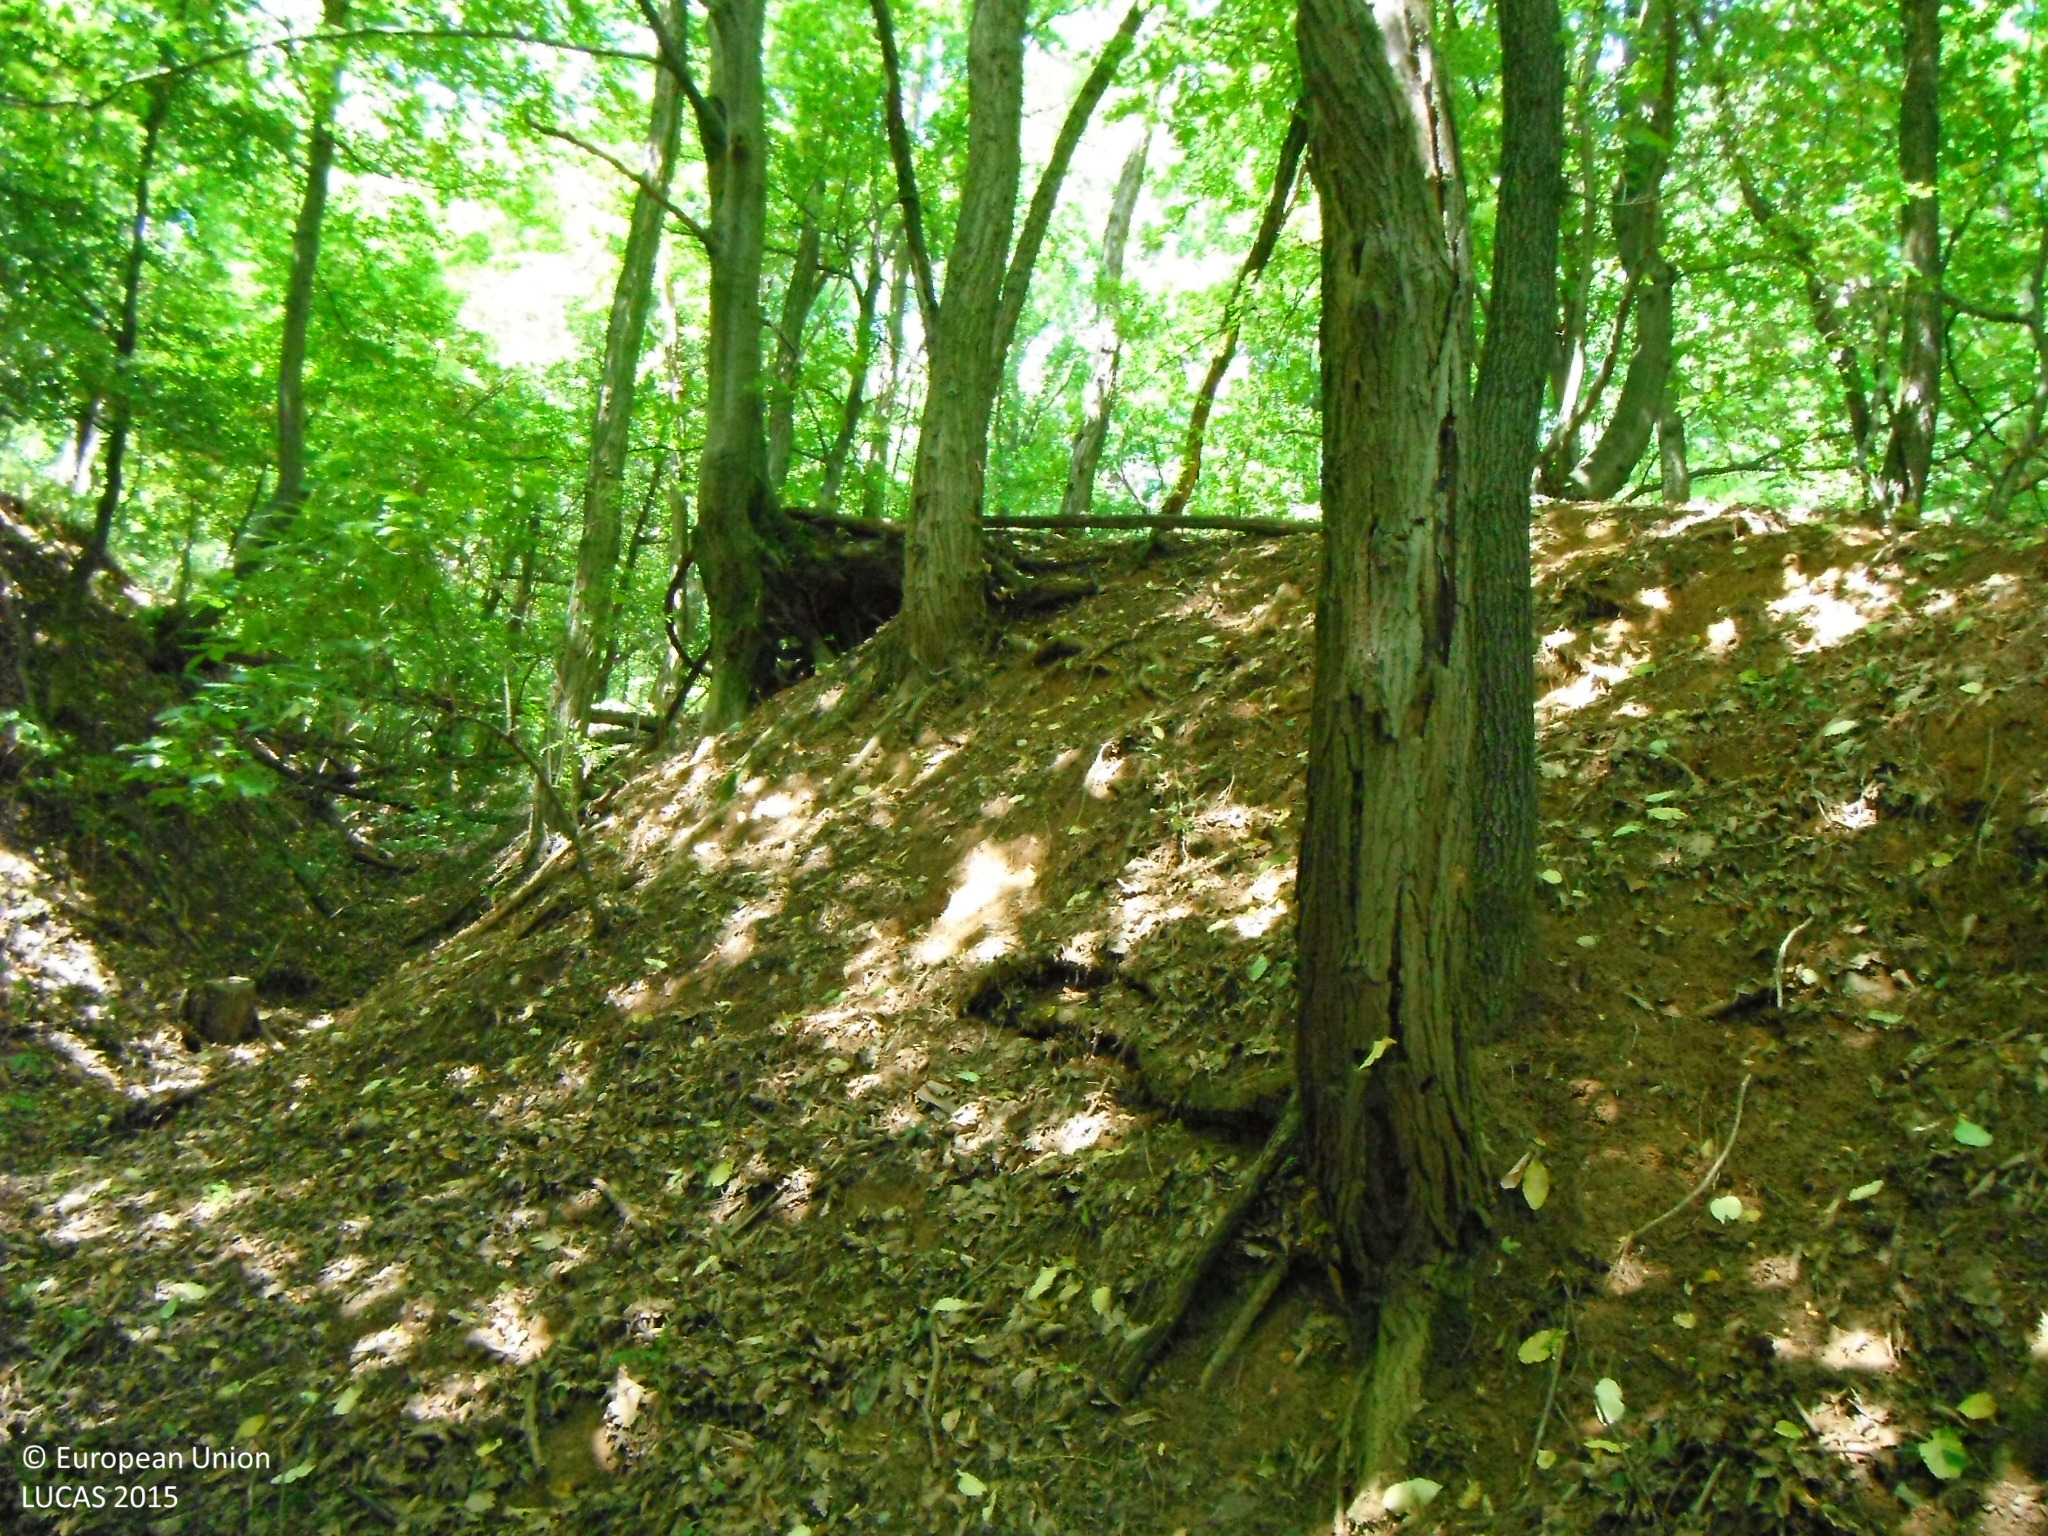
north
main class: Woodland
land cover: Broadleaved woodland
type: exotic forest
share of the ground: > 75 %
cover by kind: broadleaved forest trees 100 %
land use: Forestry
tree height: > 5 m
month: July
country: SK
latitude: 48.2054
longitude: 19.9723
